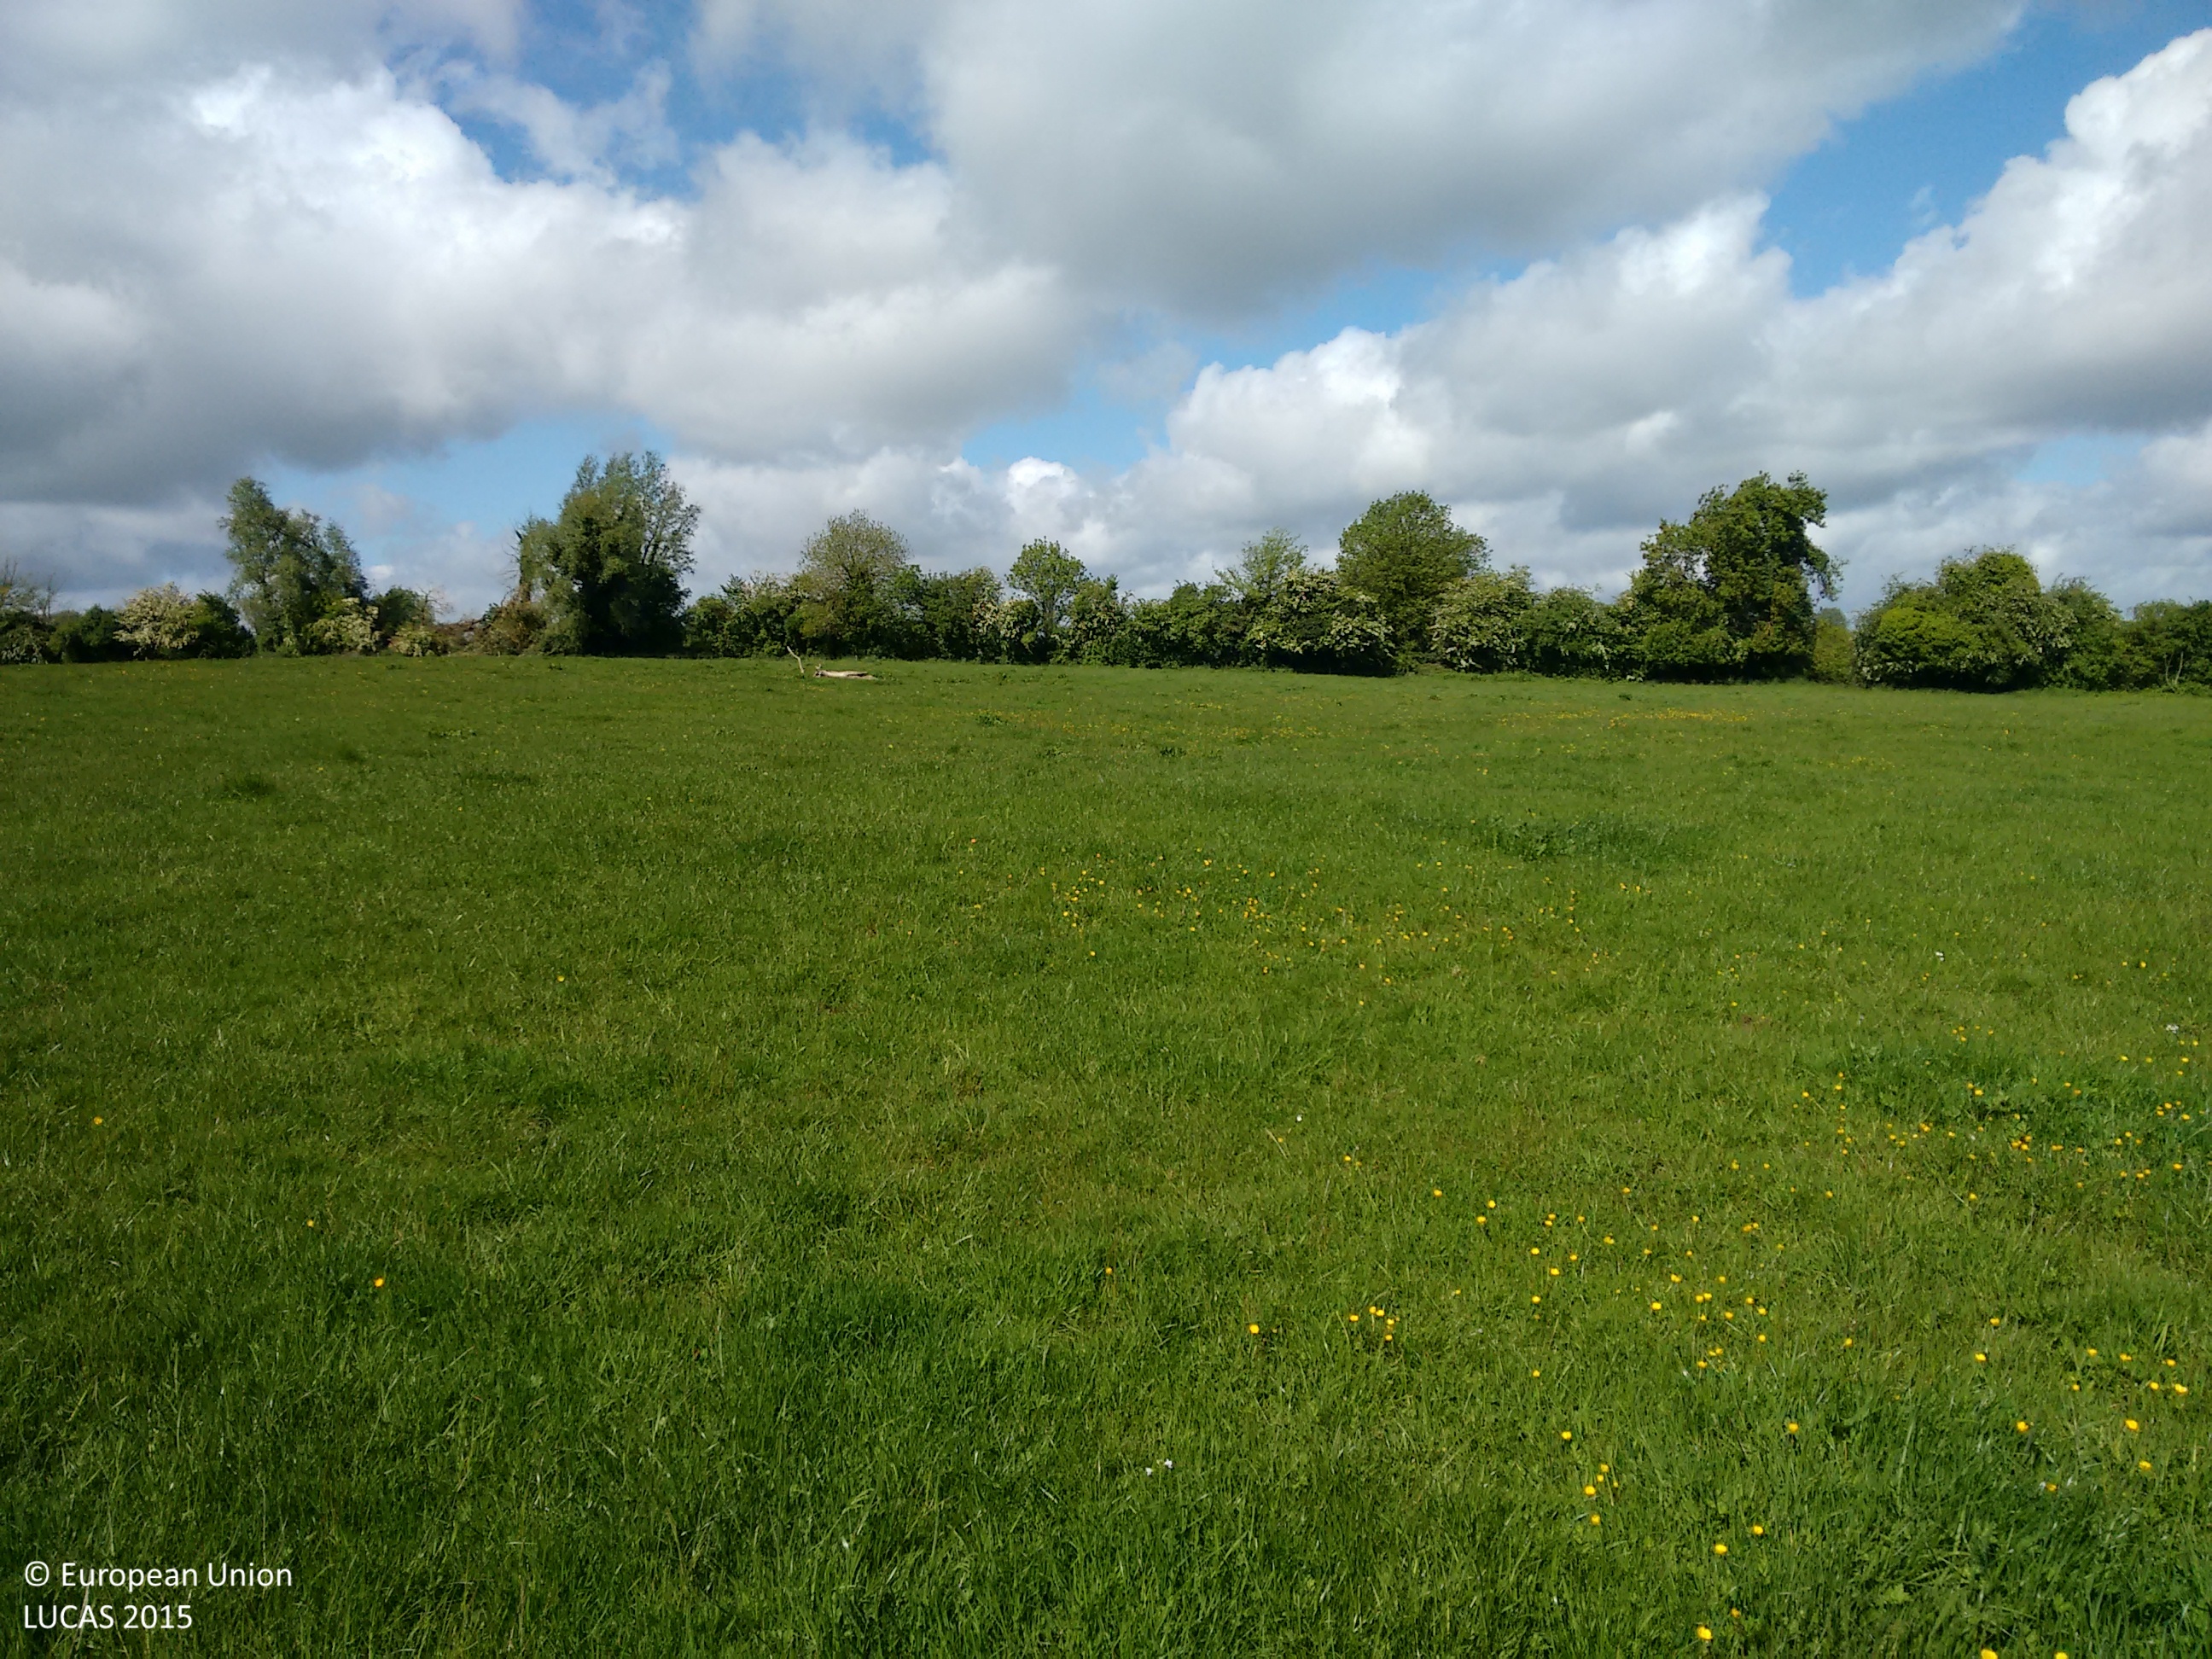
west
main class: Grassland
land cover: Grassland without tree/shrub cover
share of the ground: > 75 %
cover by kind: herbaceous plants 100 %
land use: Agriculture (excluding fallow land and kitchen gardens)
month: June
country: IE
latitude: 53.3878
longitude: -6.9660
